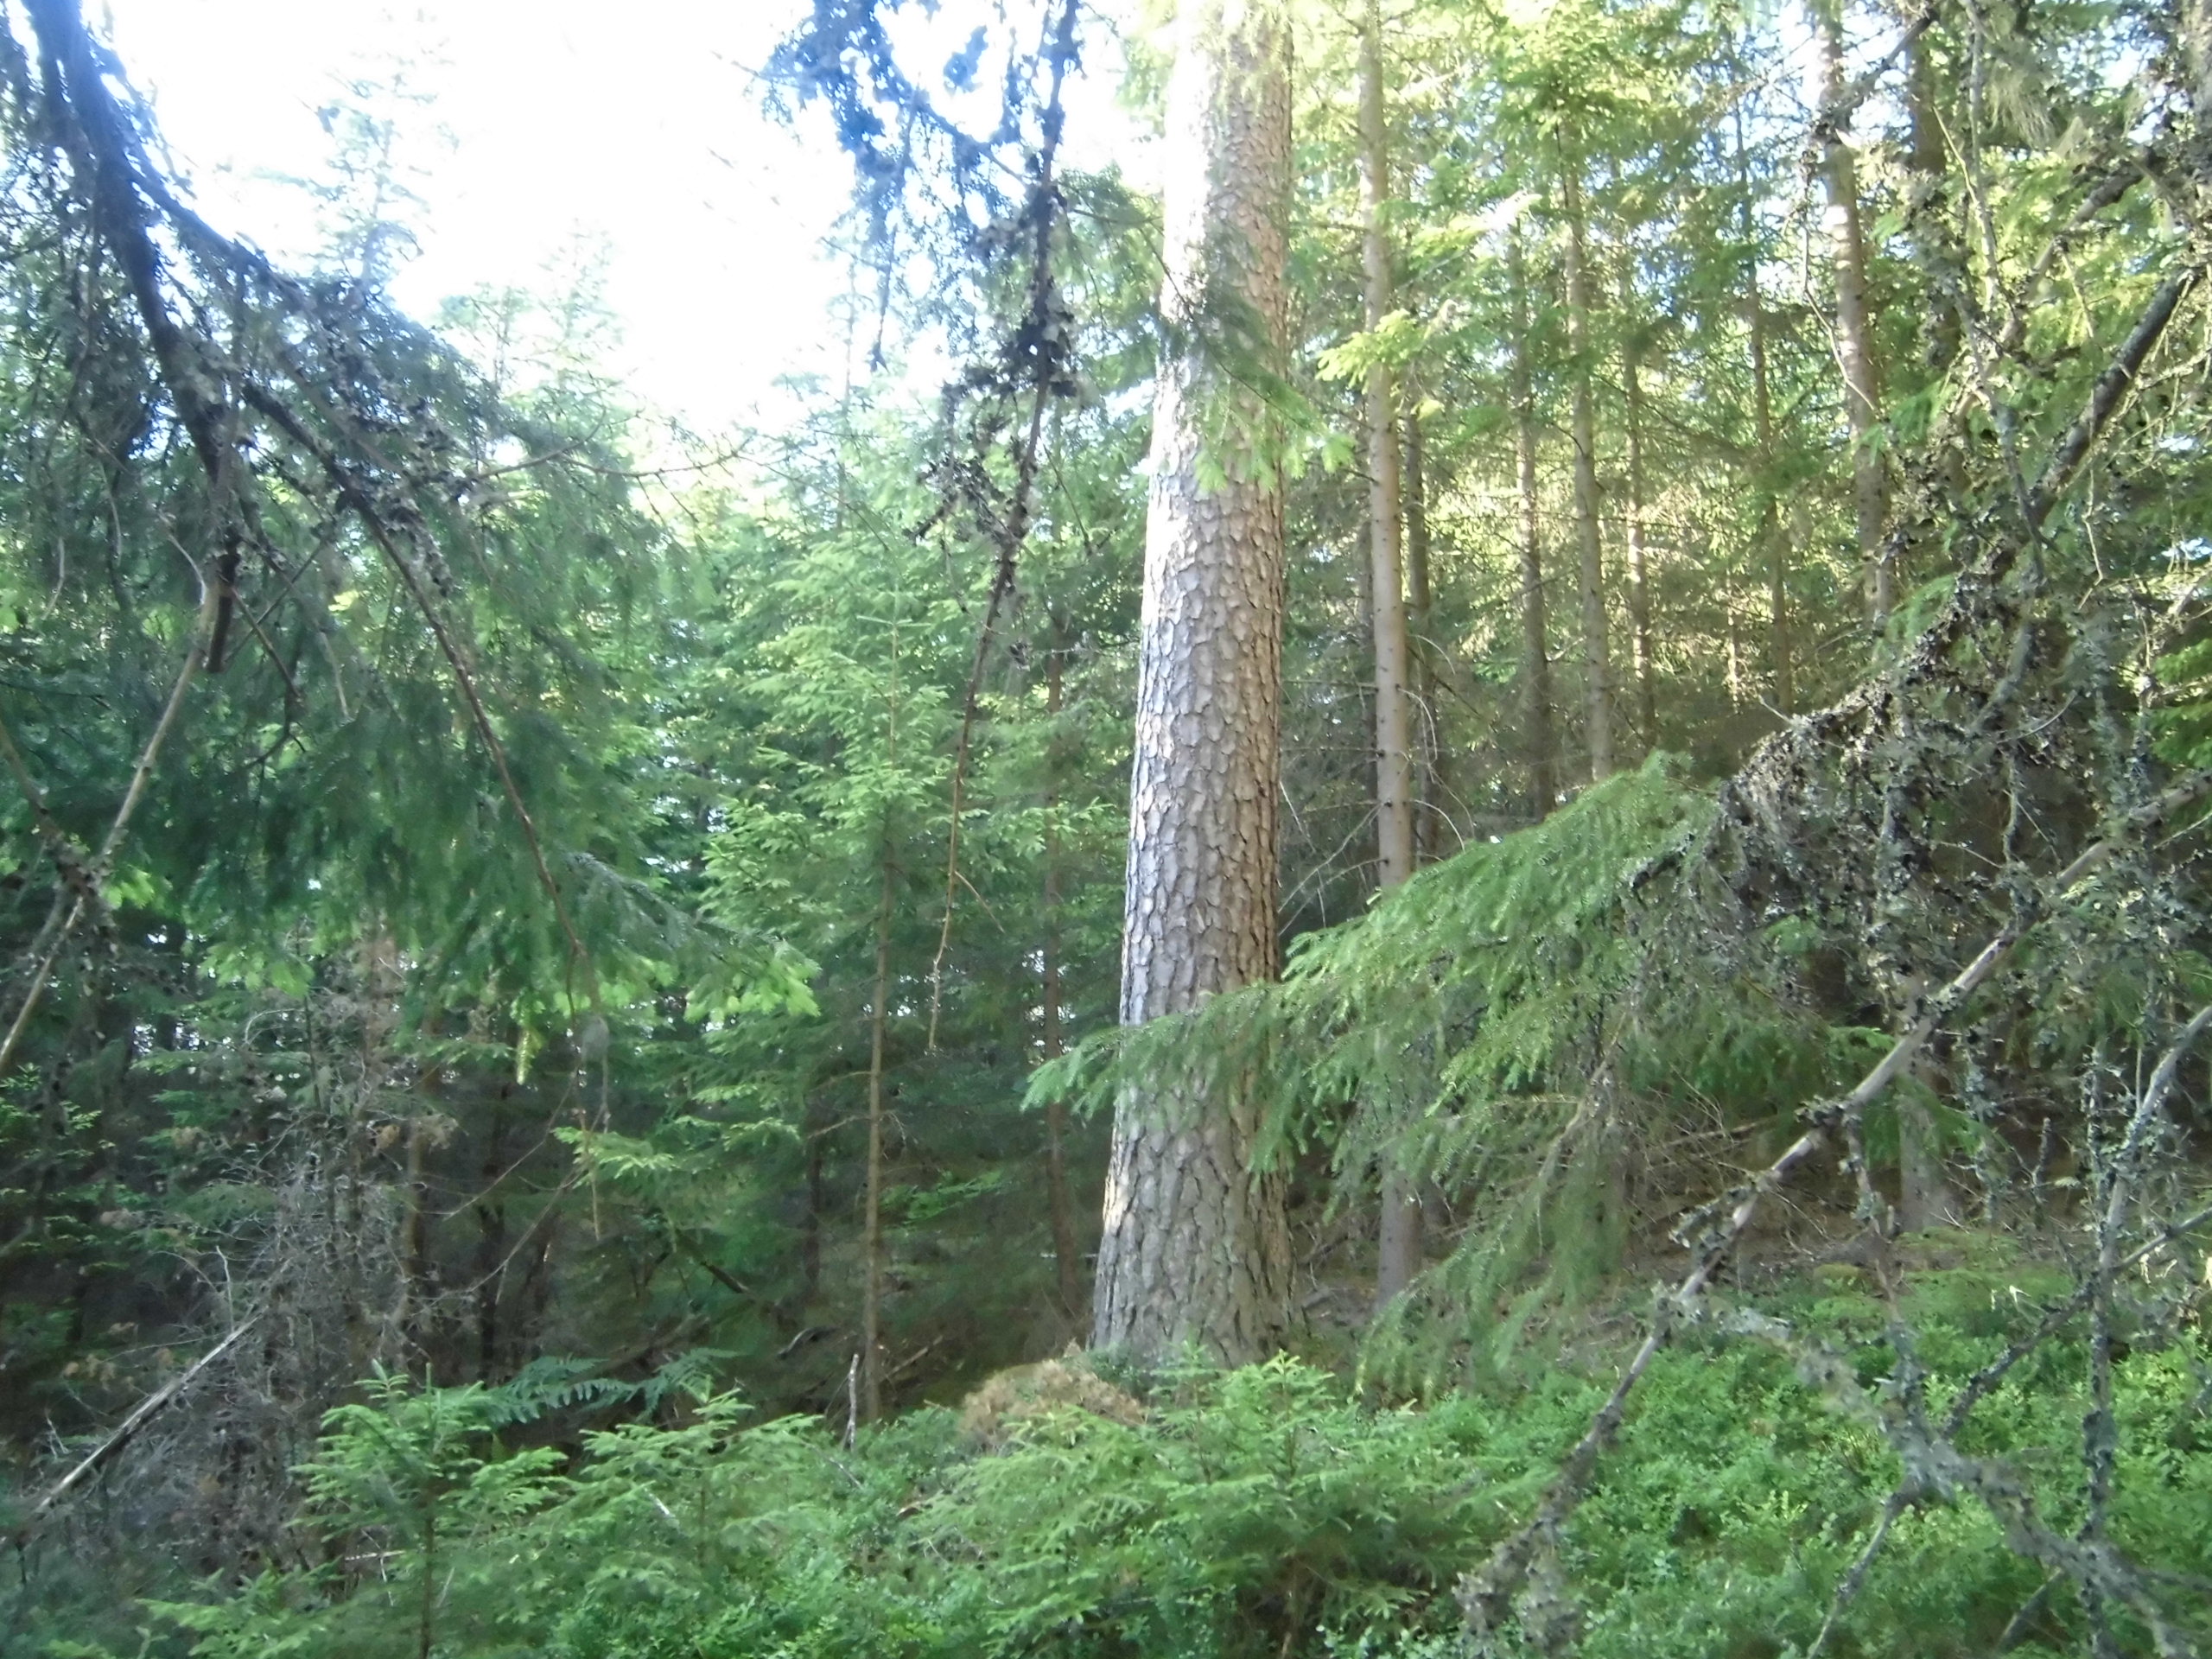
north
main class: Woodland
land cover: Spruce dominated coniferous woodland
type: boreal forest
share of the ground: 50 - 75 %
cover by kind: coniferous forest trees 70 %, lichens and mosses 15 %, shrubs 10 %, herbaceous plants 5 %
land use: Forestry
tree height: > 5 m
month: July
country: SE
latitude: 57.2491
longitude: 15.3172
